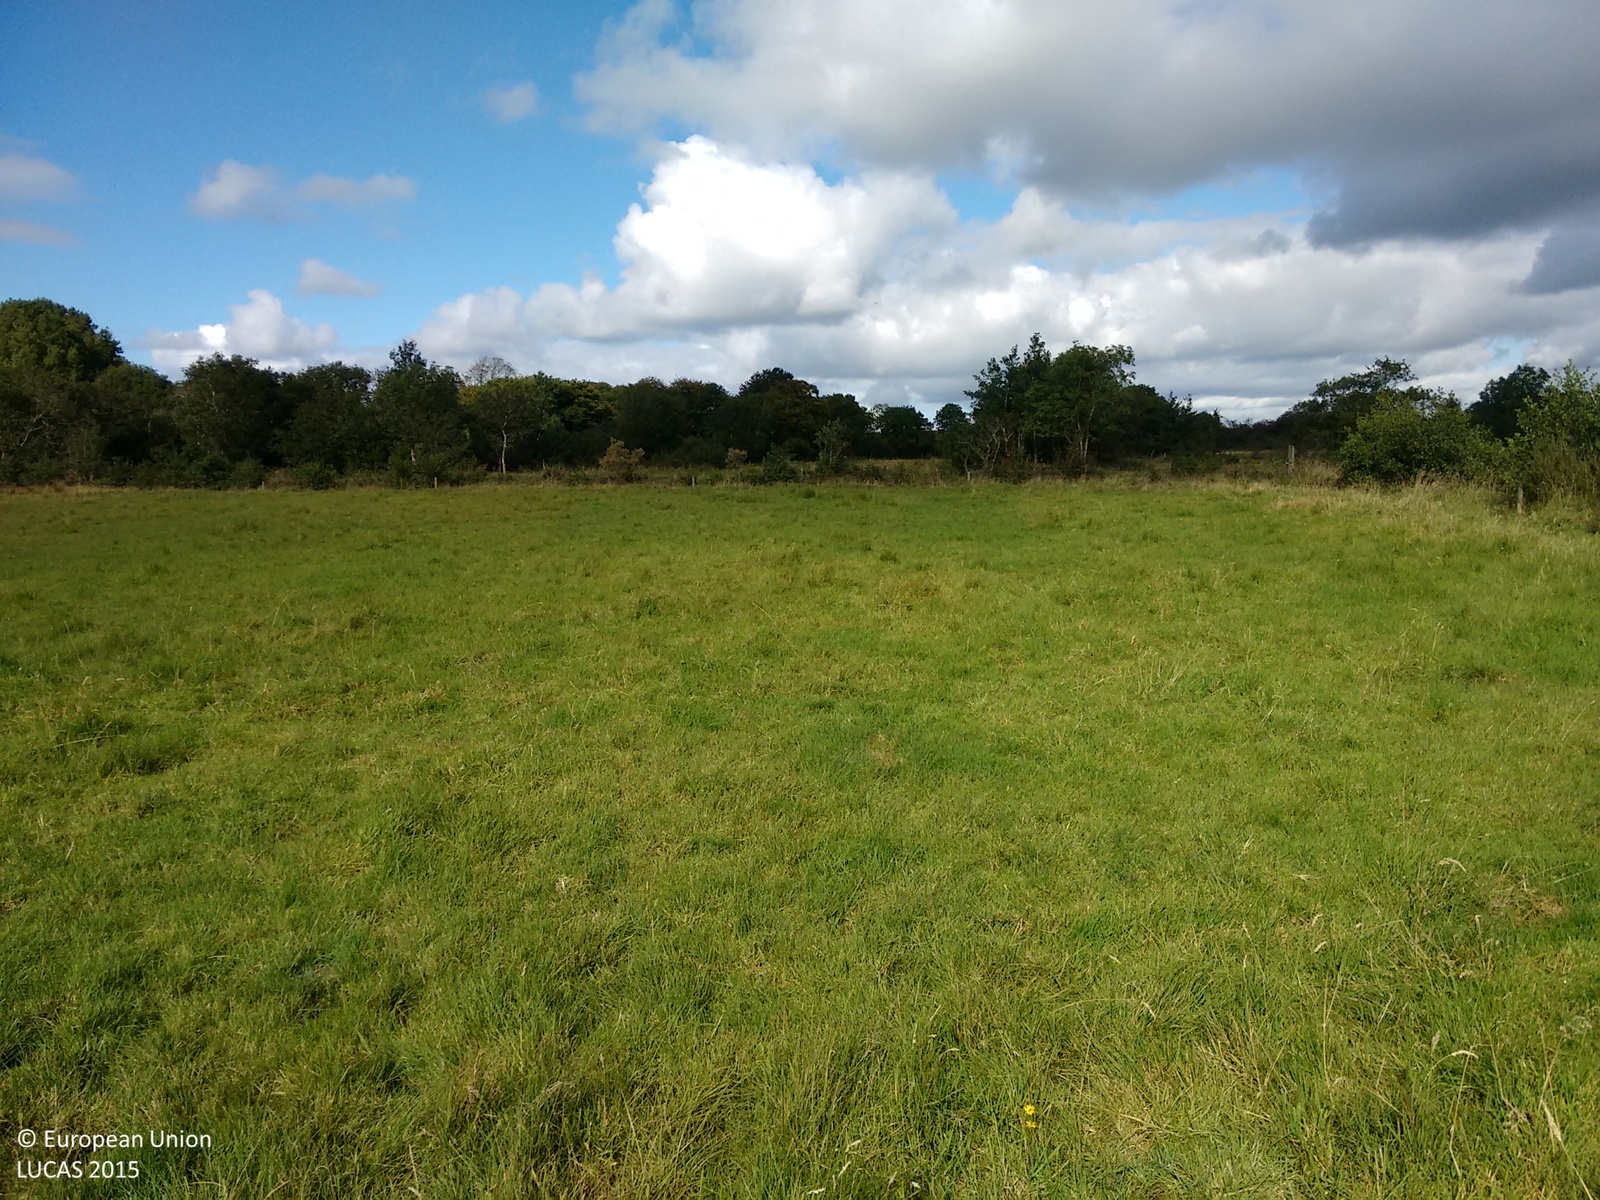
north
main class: Grassland
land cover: Grassland without tree/shrub cover
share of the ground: > 75 %
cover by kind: herbaceous plants 100 %
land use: Agriculture (excluding fallow land and kitchen gardens)
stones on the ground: < 10 %
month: September
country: IE
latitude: 53.7257
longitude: -8.8955
